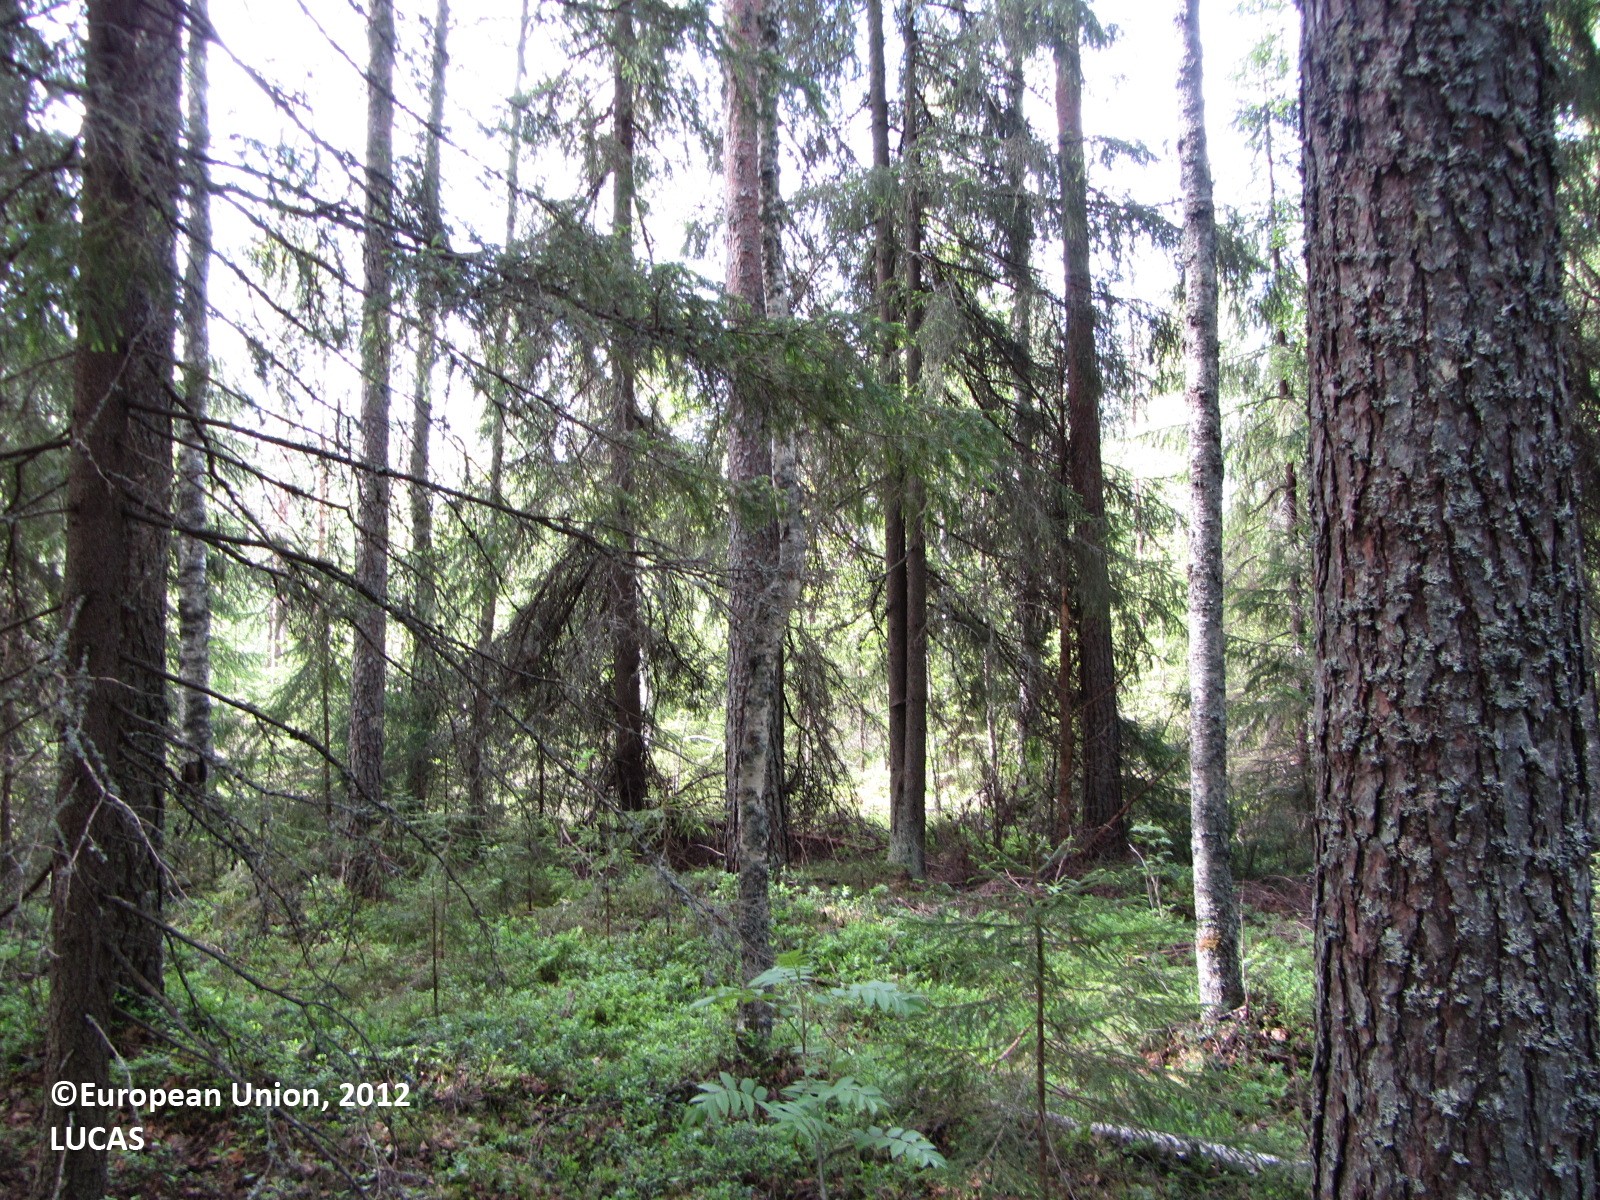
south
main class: Woodland
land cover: Spruce dominated mixed woodland
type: boreal forest
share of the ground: > 75 %
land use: Forestry
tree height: > 5 m
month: June
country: FI
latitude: 61.8034
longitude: 24.9607
